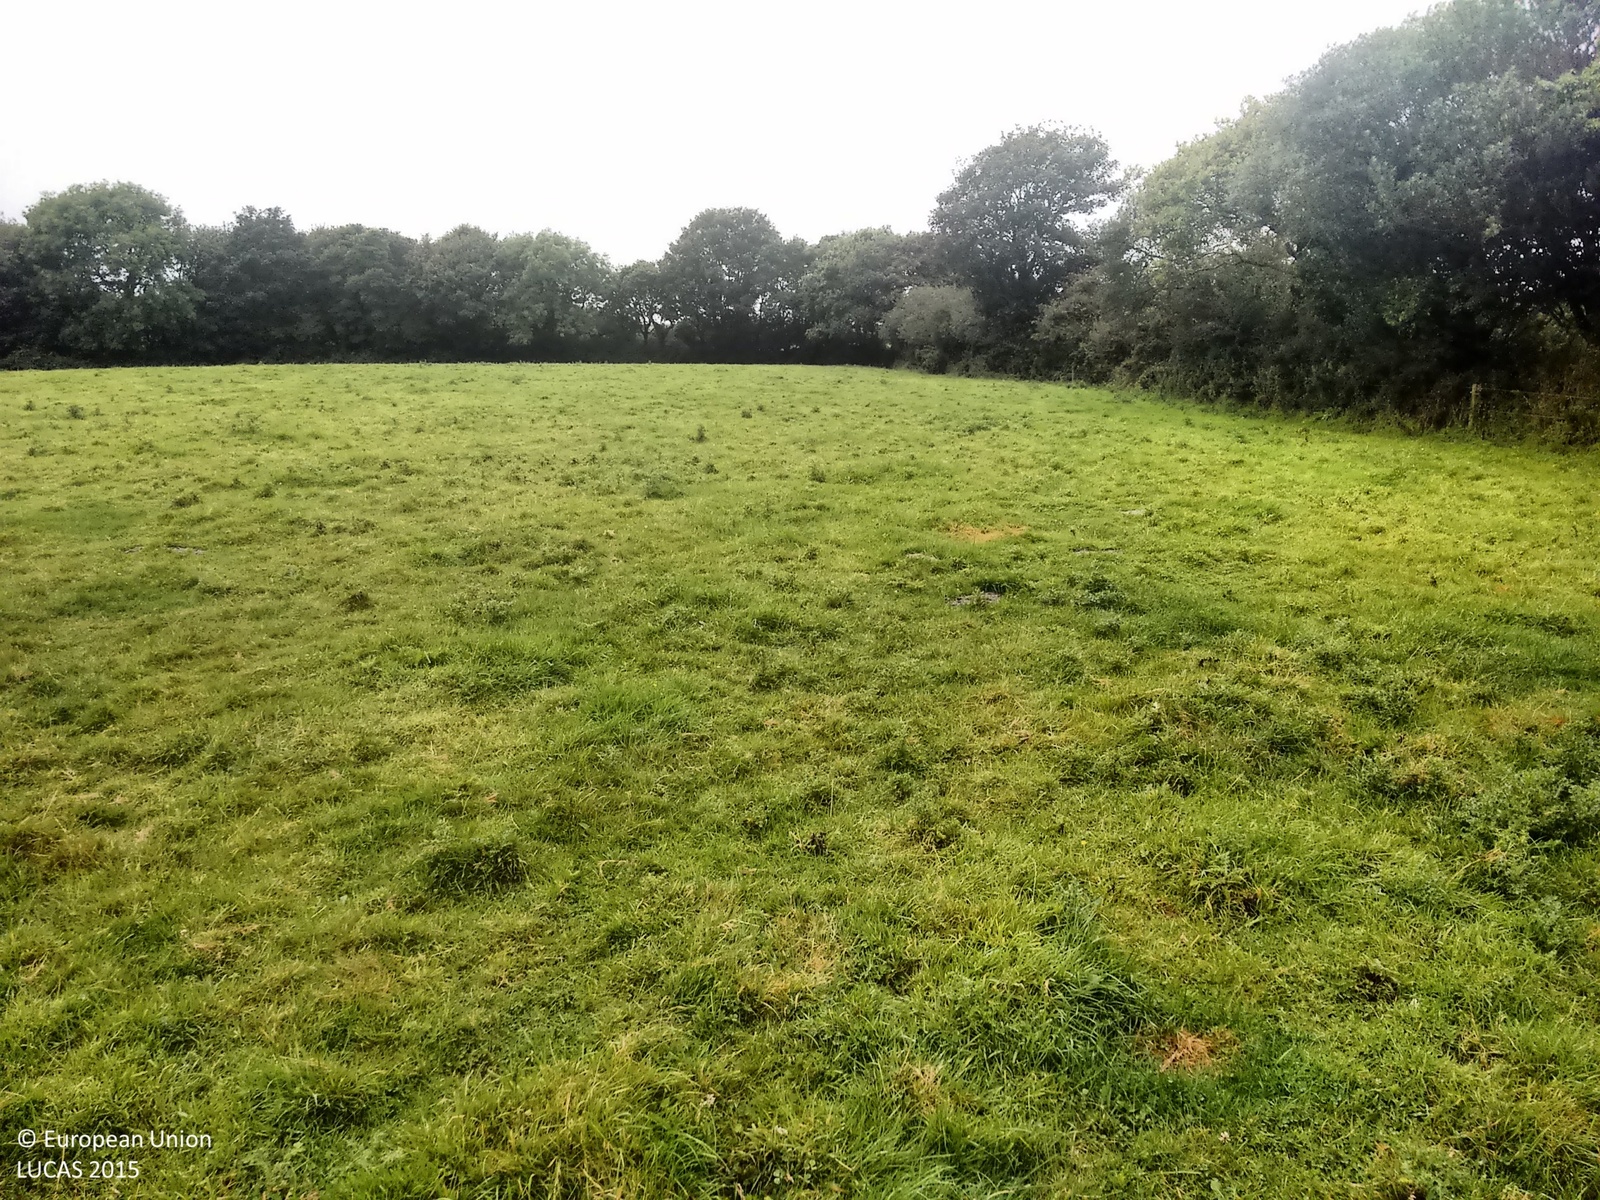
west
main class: Grassland
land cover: Grassland without tree/shrub cover
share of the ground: > 75 %
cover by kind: herbaceous plants 100 %
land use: Agriculture (excluding fallow land and kitchen gardens)
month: August
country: GB
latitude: 50.0803
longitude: -5.1411
